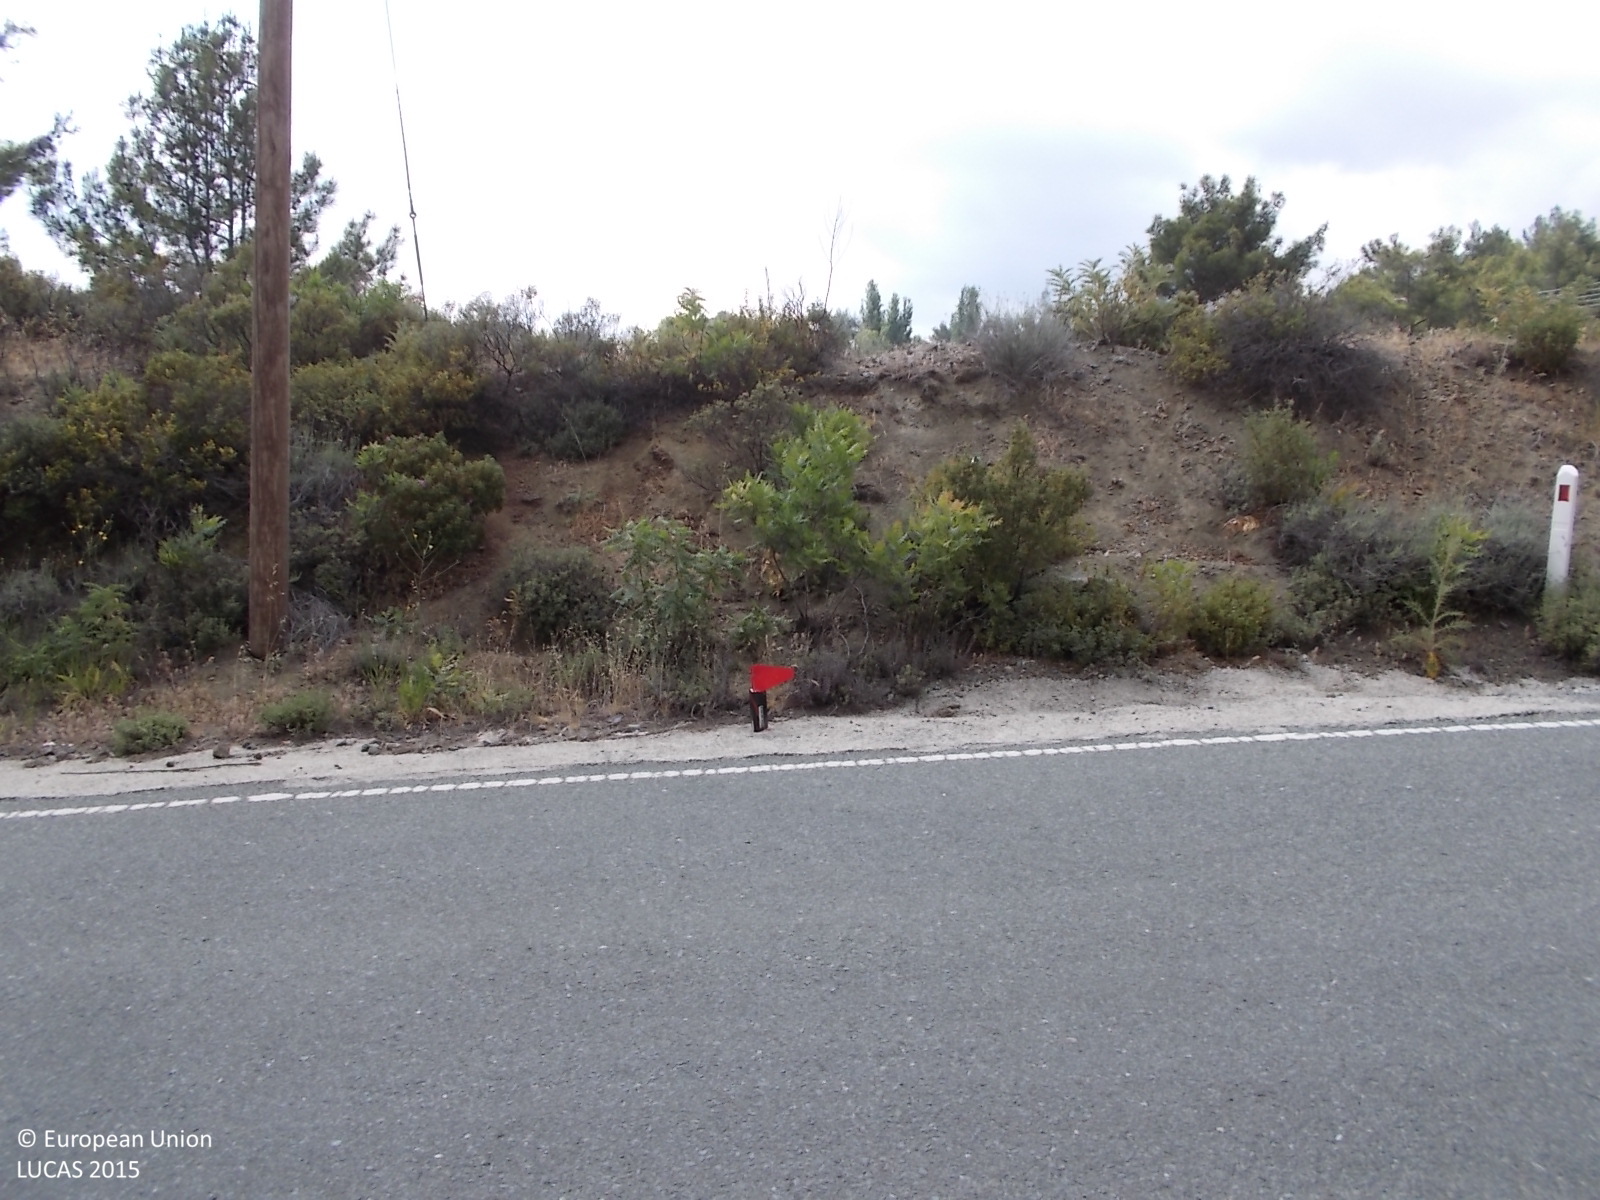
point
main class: Shrubland
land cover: Shrubland with sparse tree cover
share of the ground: 25 - 50 %
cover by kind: unconsolidated bare surface 50 %, shrubs 45 %, coniferous forest trees 5 %
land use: Semi-natural and natural areas not in use
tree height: > 5 m
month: June
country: CY
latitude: 34.8892
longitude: 32.8471
